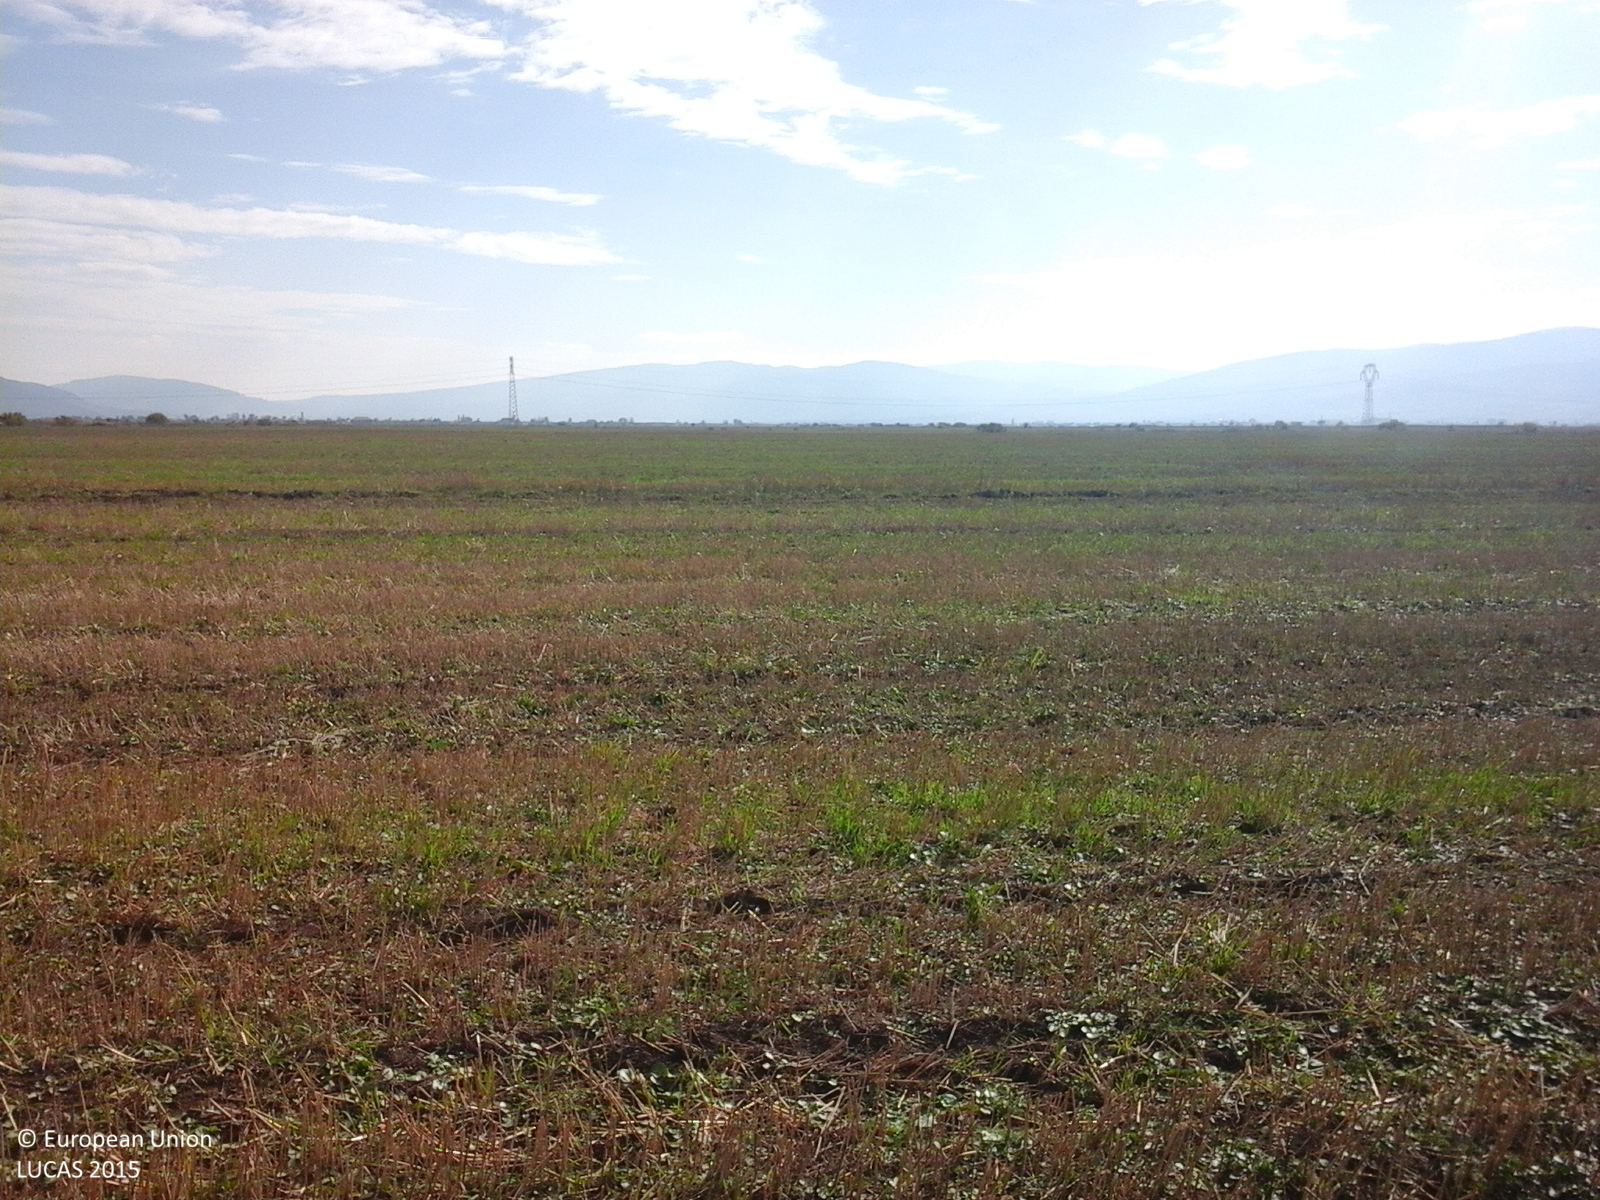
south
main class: Cropland
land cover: Oats
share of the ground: > 75 %
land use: Agriculture (excluding fallow land and kitchen gardens)
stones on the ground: < 10 %
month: October
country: RO
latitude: 46.7068
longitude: 25.5591
